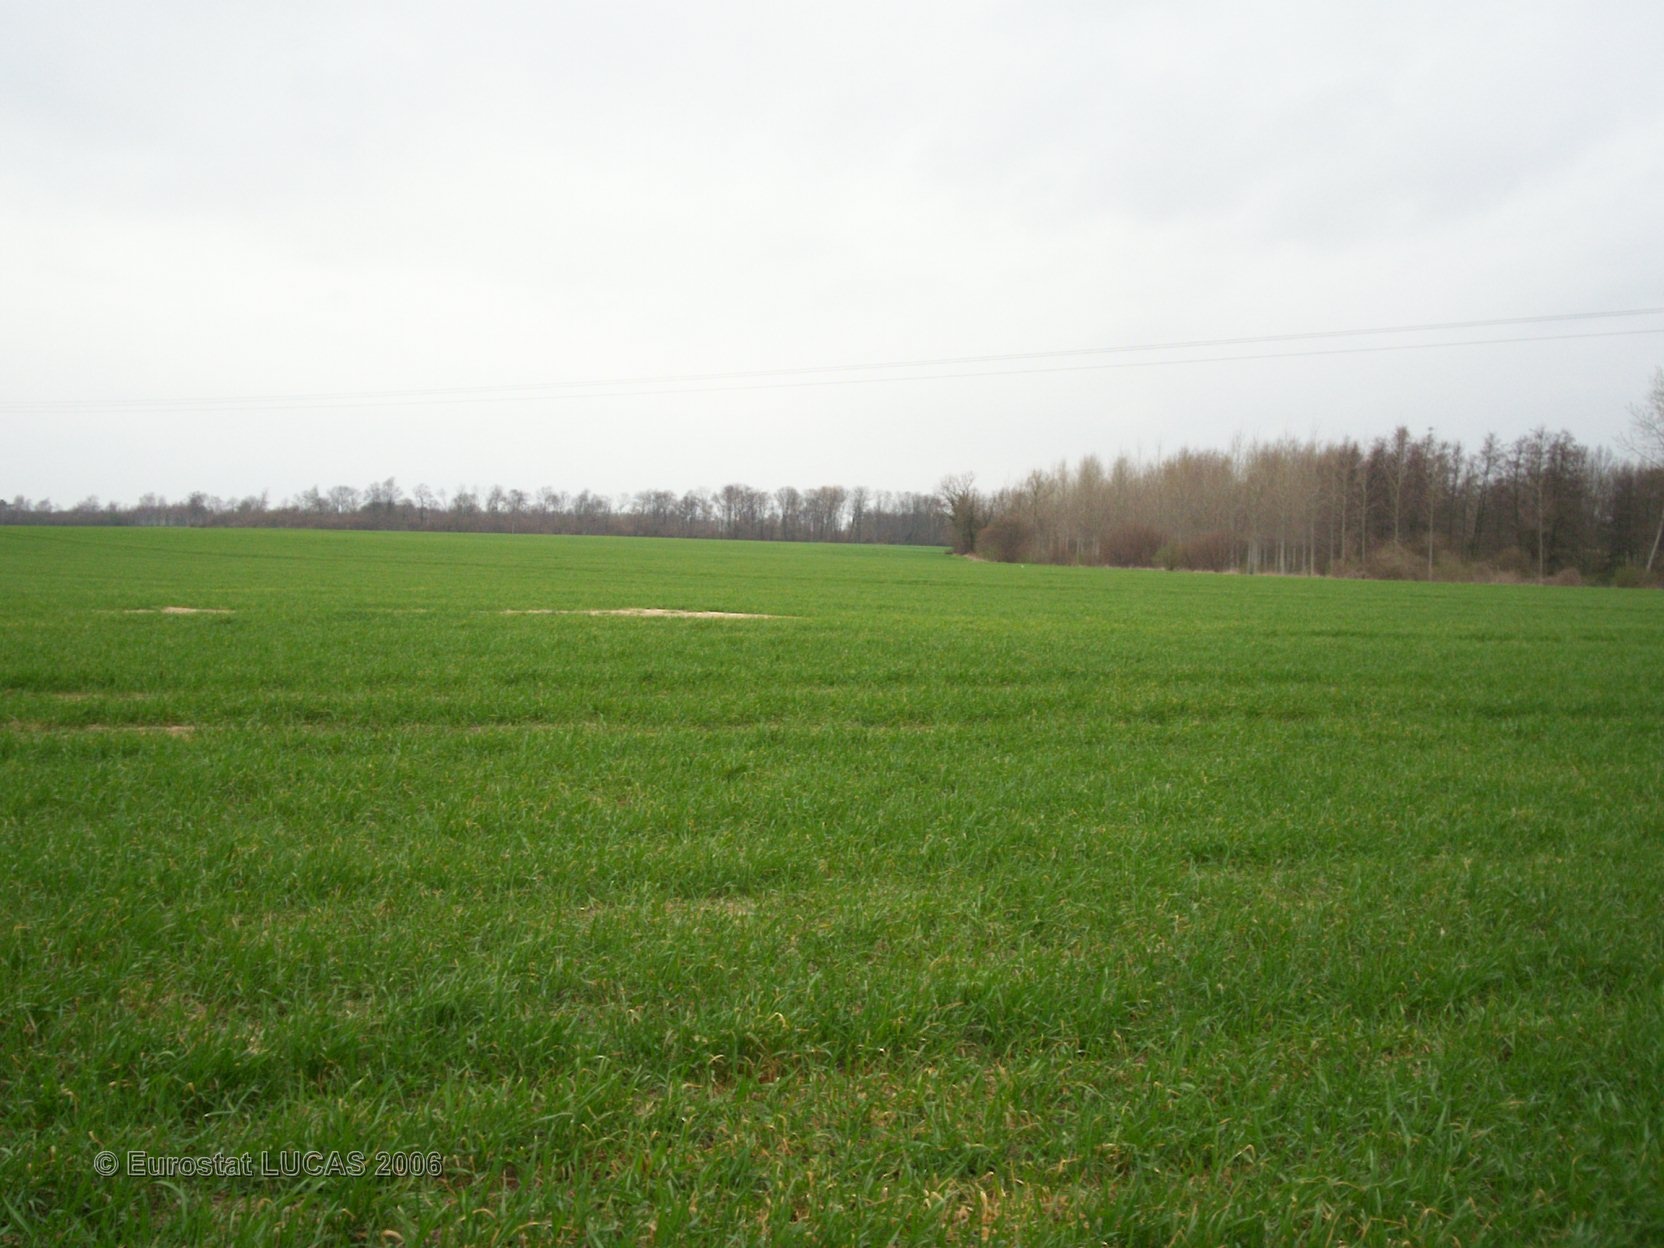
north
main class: Cropland
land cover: Common wheat
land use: Agriculture (excluding fallow land and kitchen gardens)
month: April
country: FR
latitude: 49.1833
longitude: 4.4400
